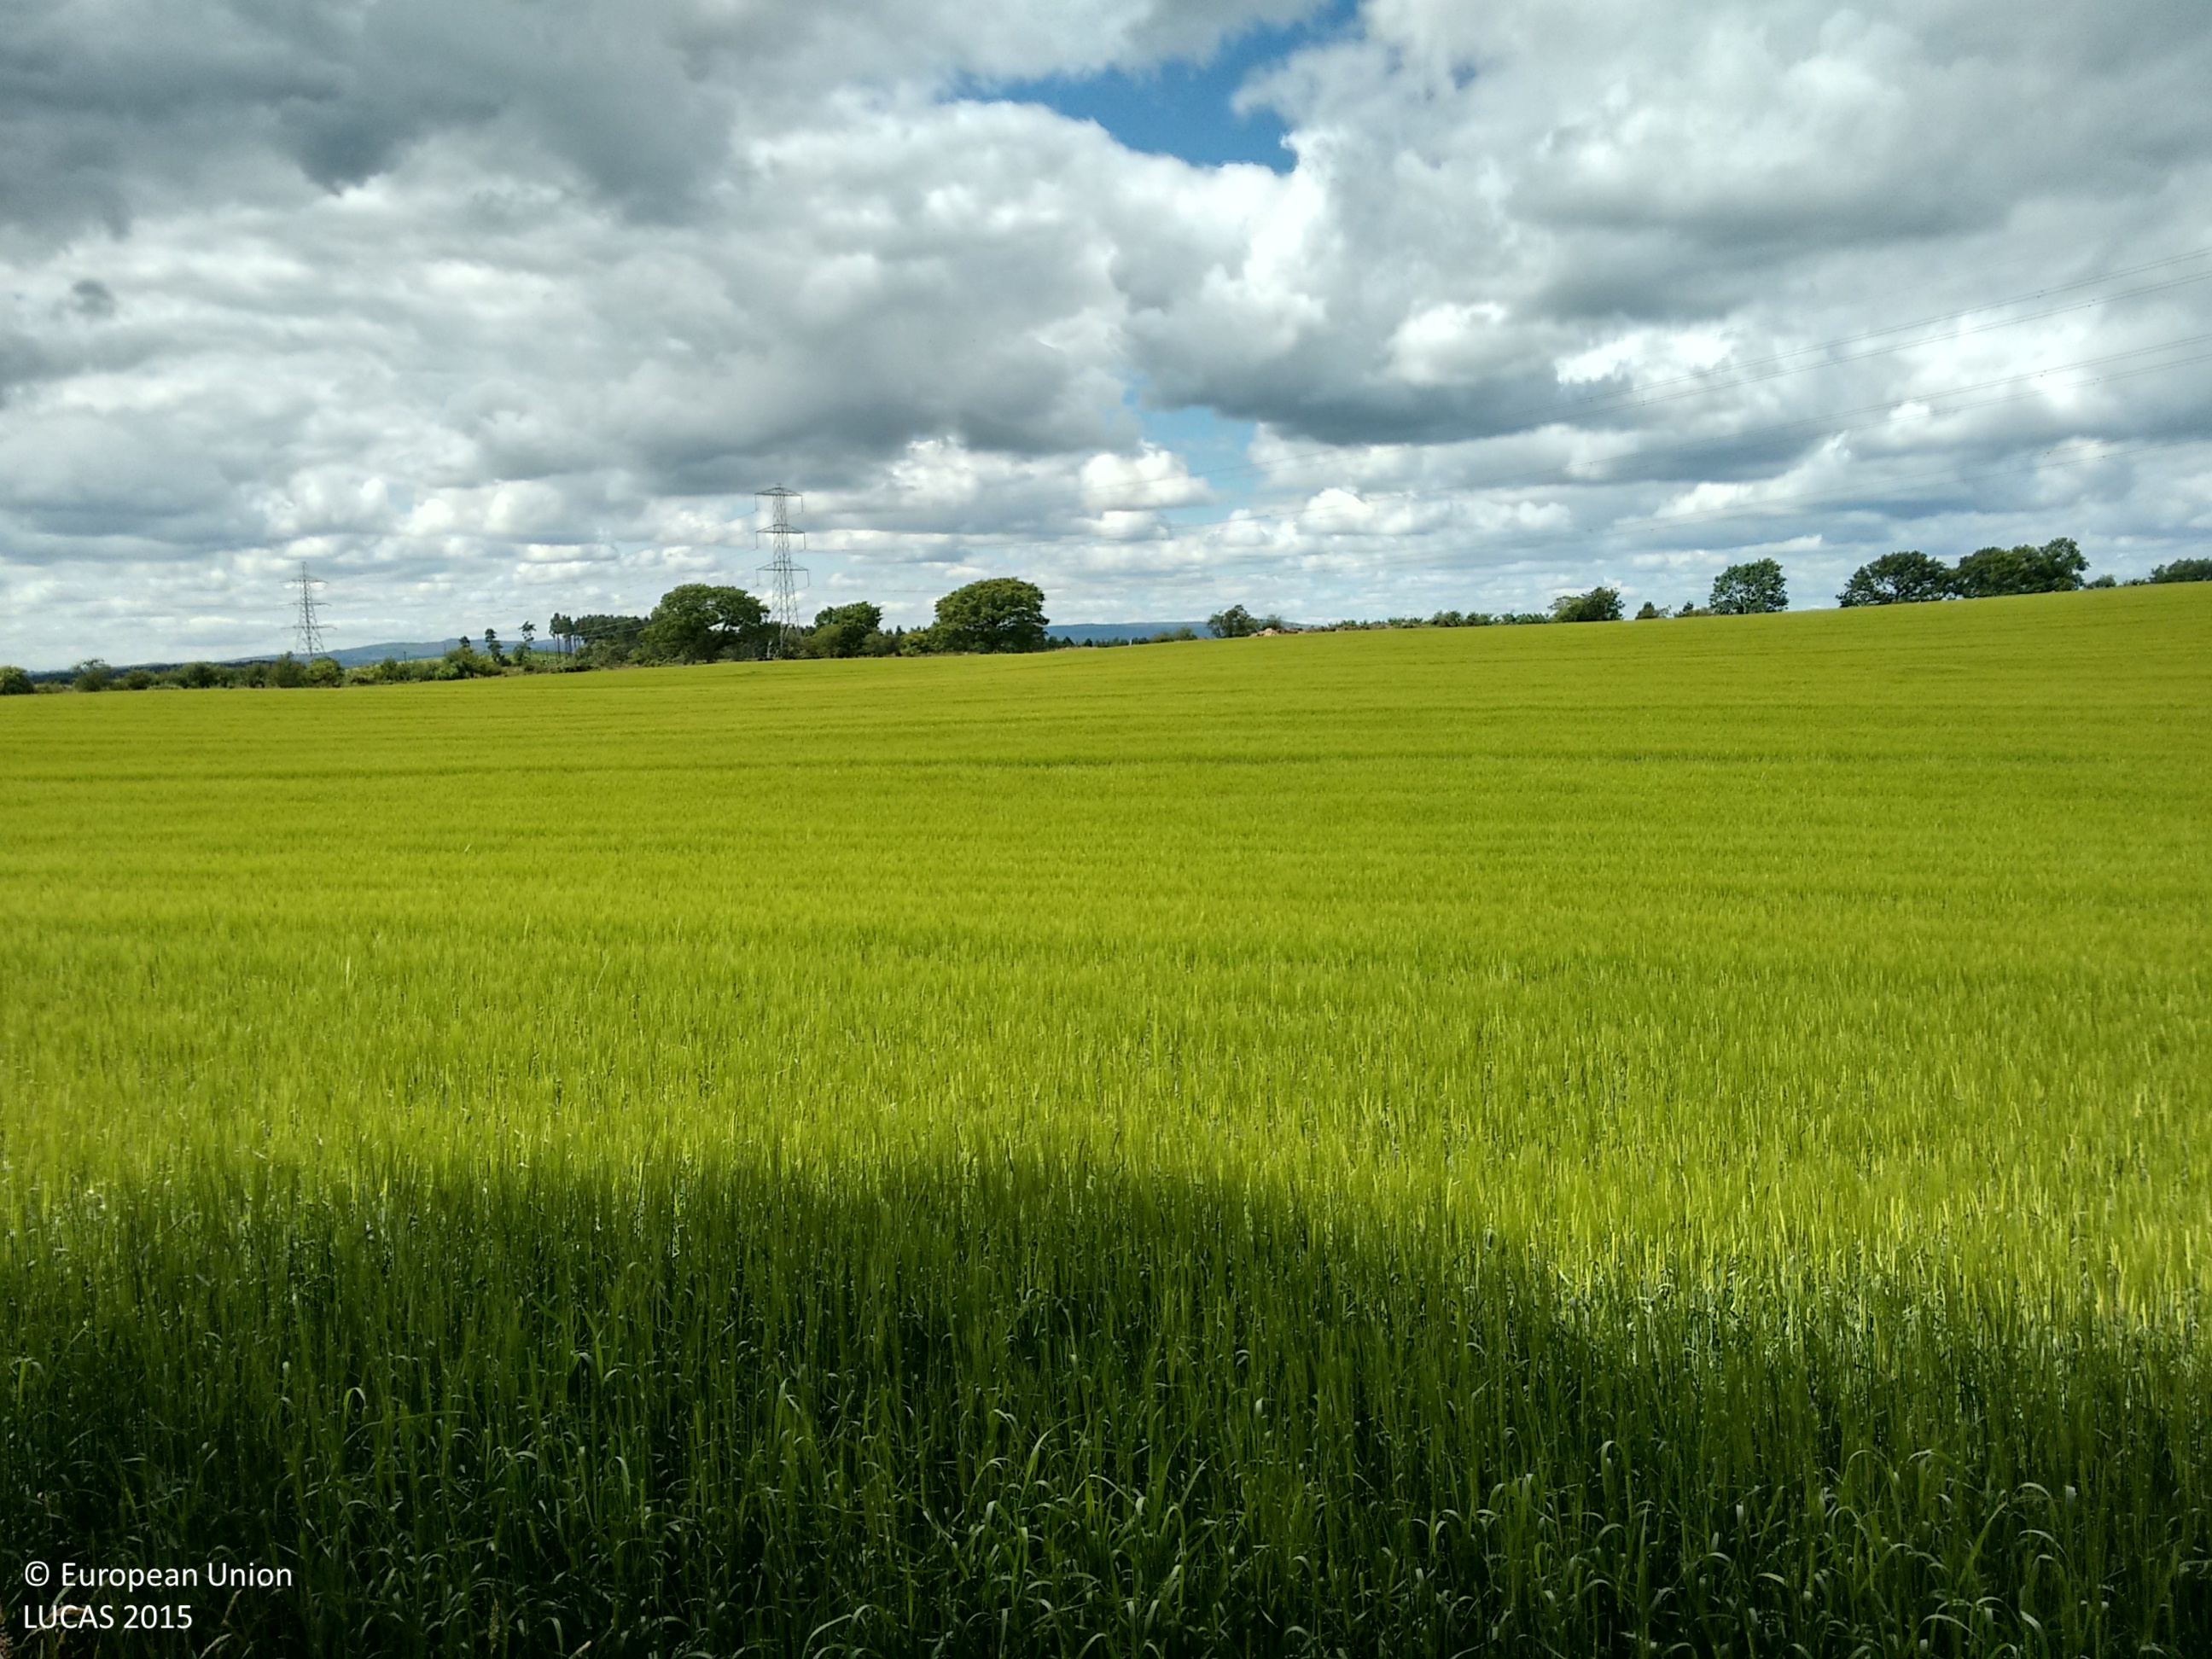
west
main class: Woodland
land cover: Pine dominated mixed woodland
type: exotic forest
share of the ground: > 75 %
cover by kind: coniferous forest trees 65 %, broadleaved forest trees 25 %, herbaceous plants 10 %
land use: Agriculture (excluding fallow land and kitchen gardens)
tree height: > 5 m
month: July
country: GB
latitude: 56.1060
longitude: -3.6994
